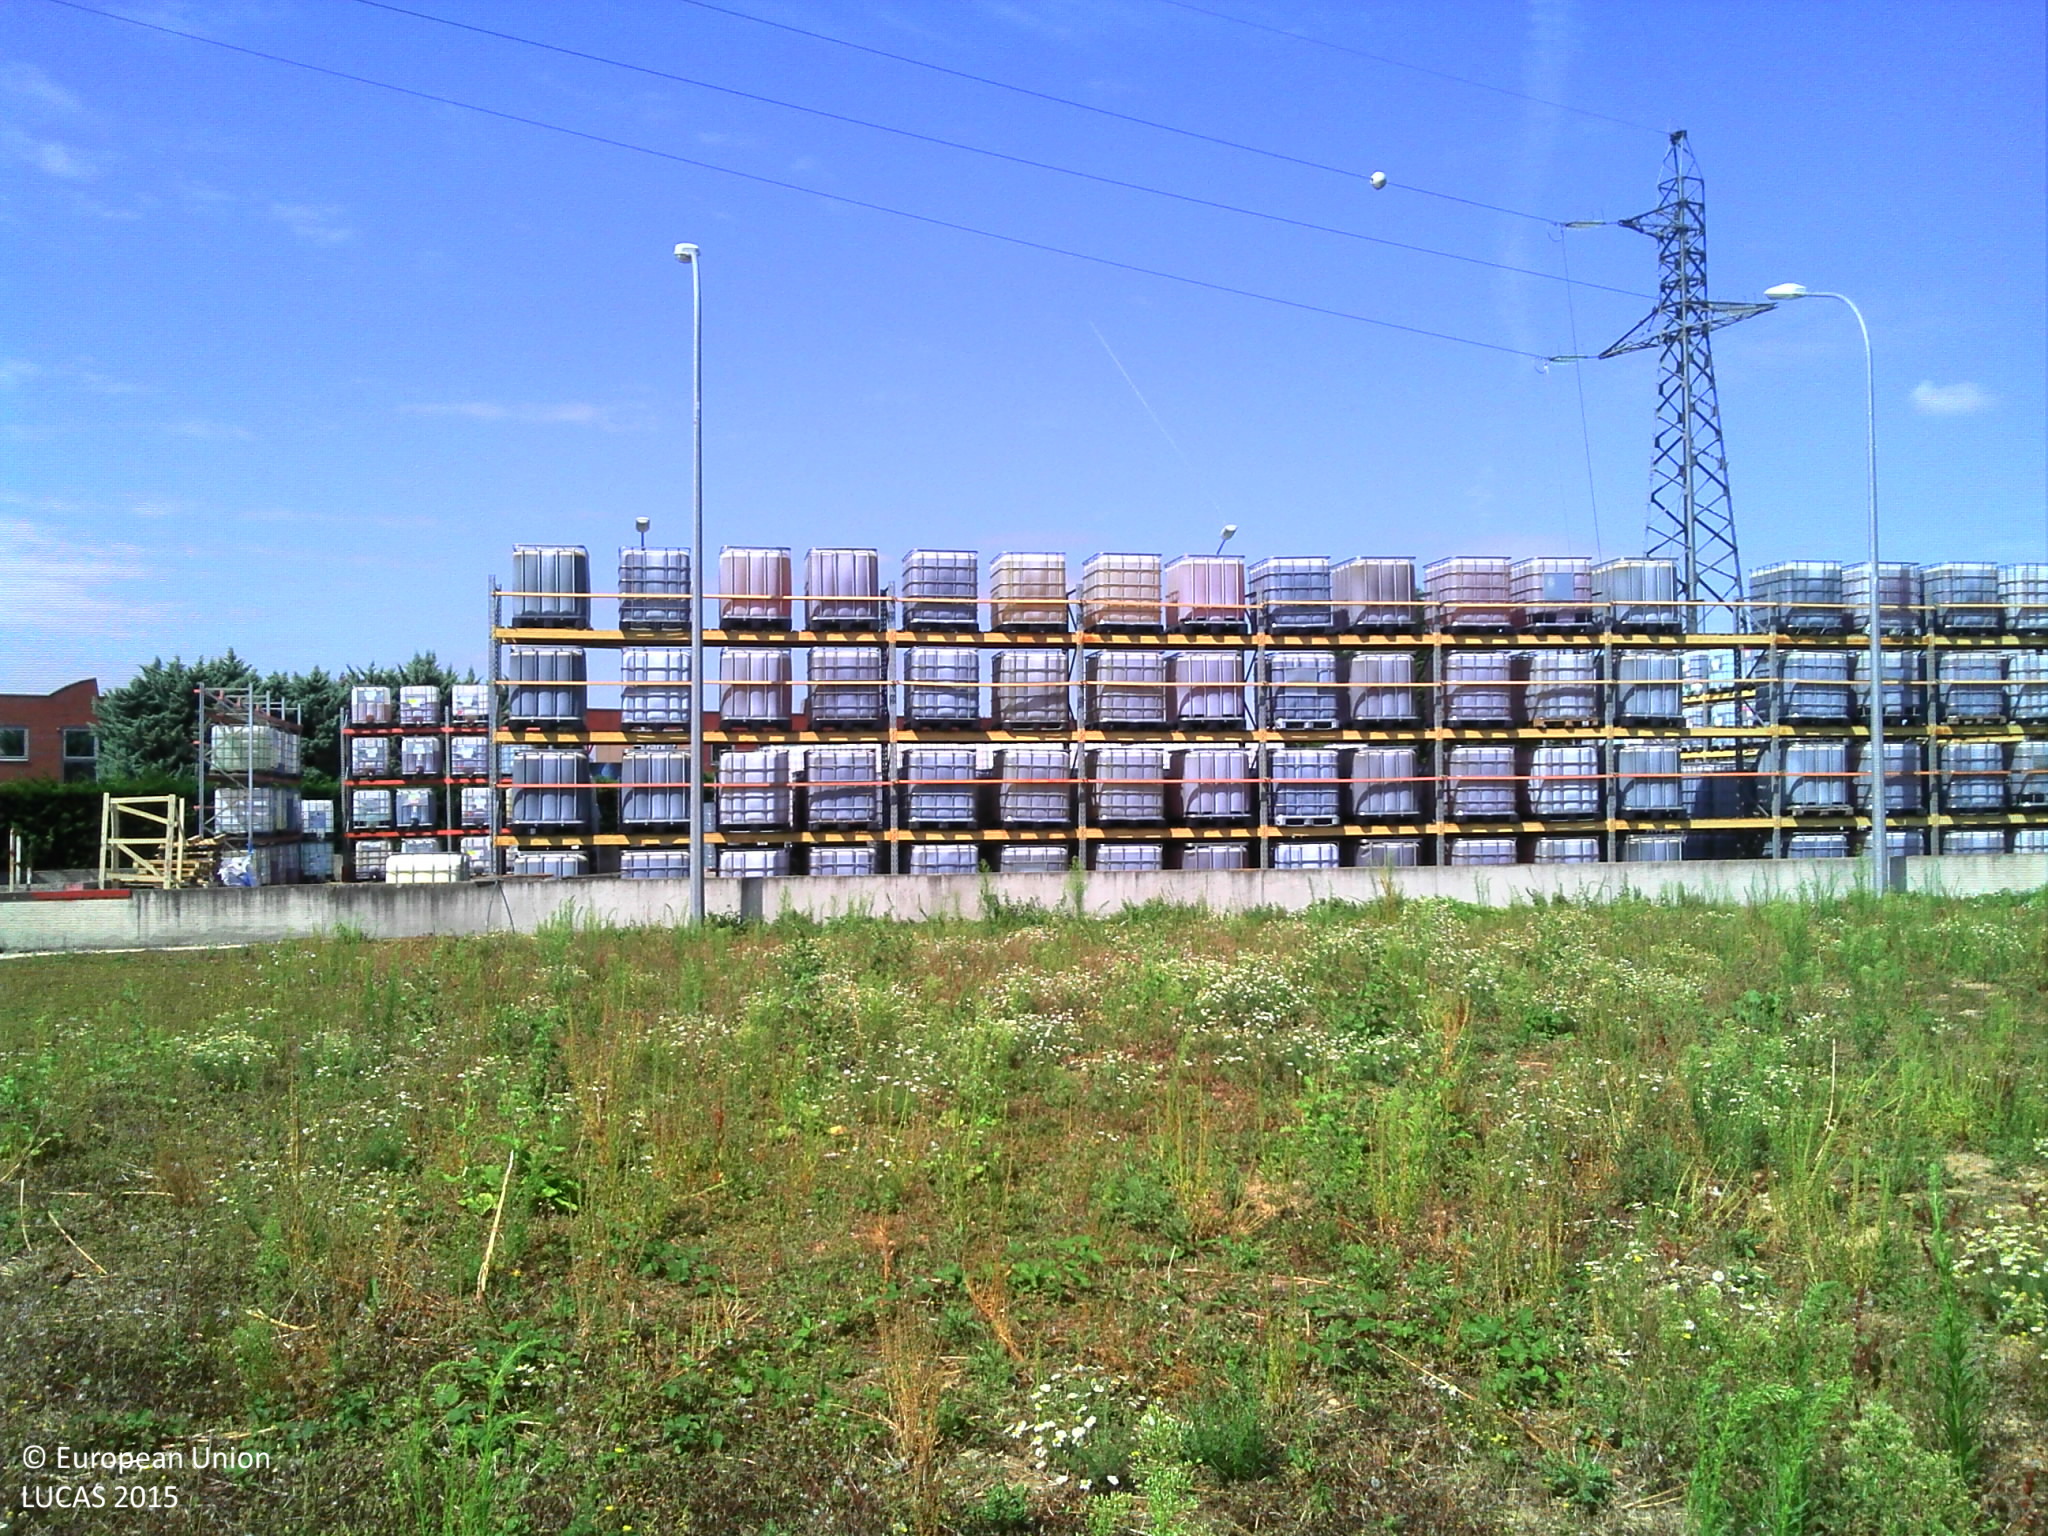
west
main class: Grassland
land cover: Spontaneously vegetated surfaces
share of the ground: > 75 %
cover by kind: herbaceous plants 90 %, consolidated bare surface 10 %
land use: Logistics and storage
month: July
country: FR
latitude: 48.6230
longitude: 2.5686
